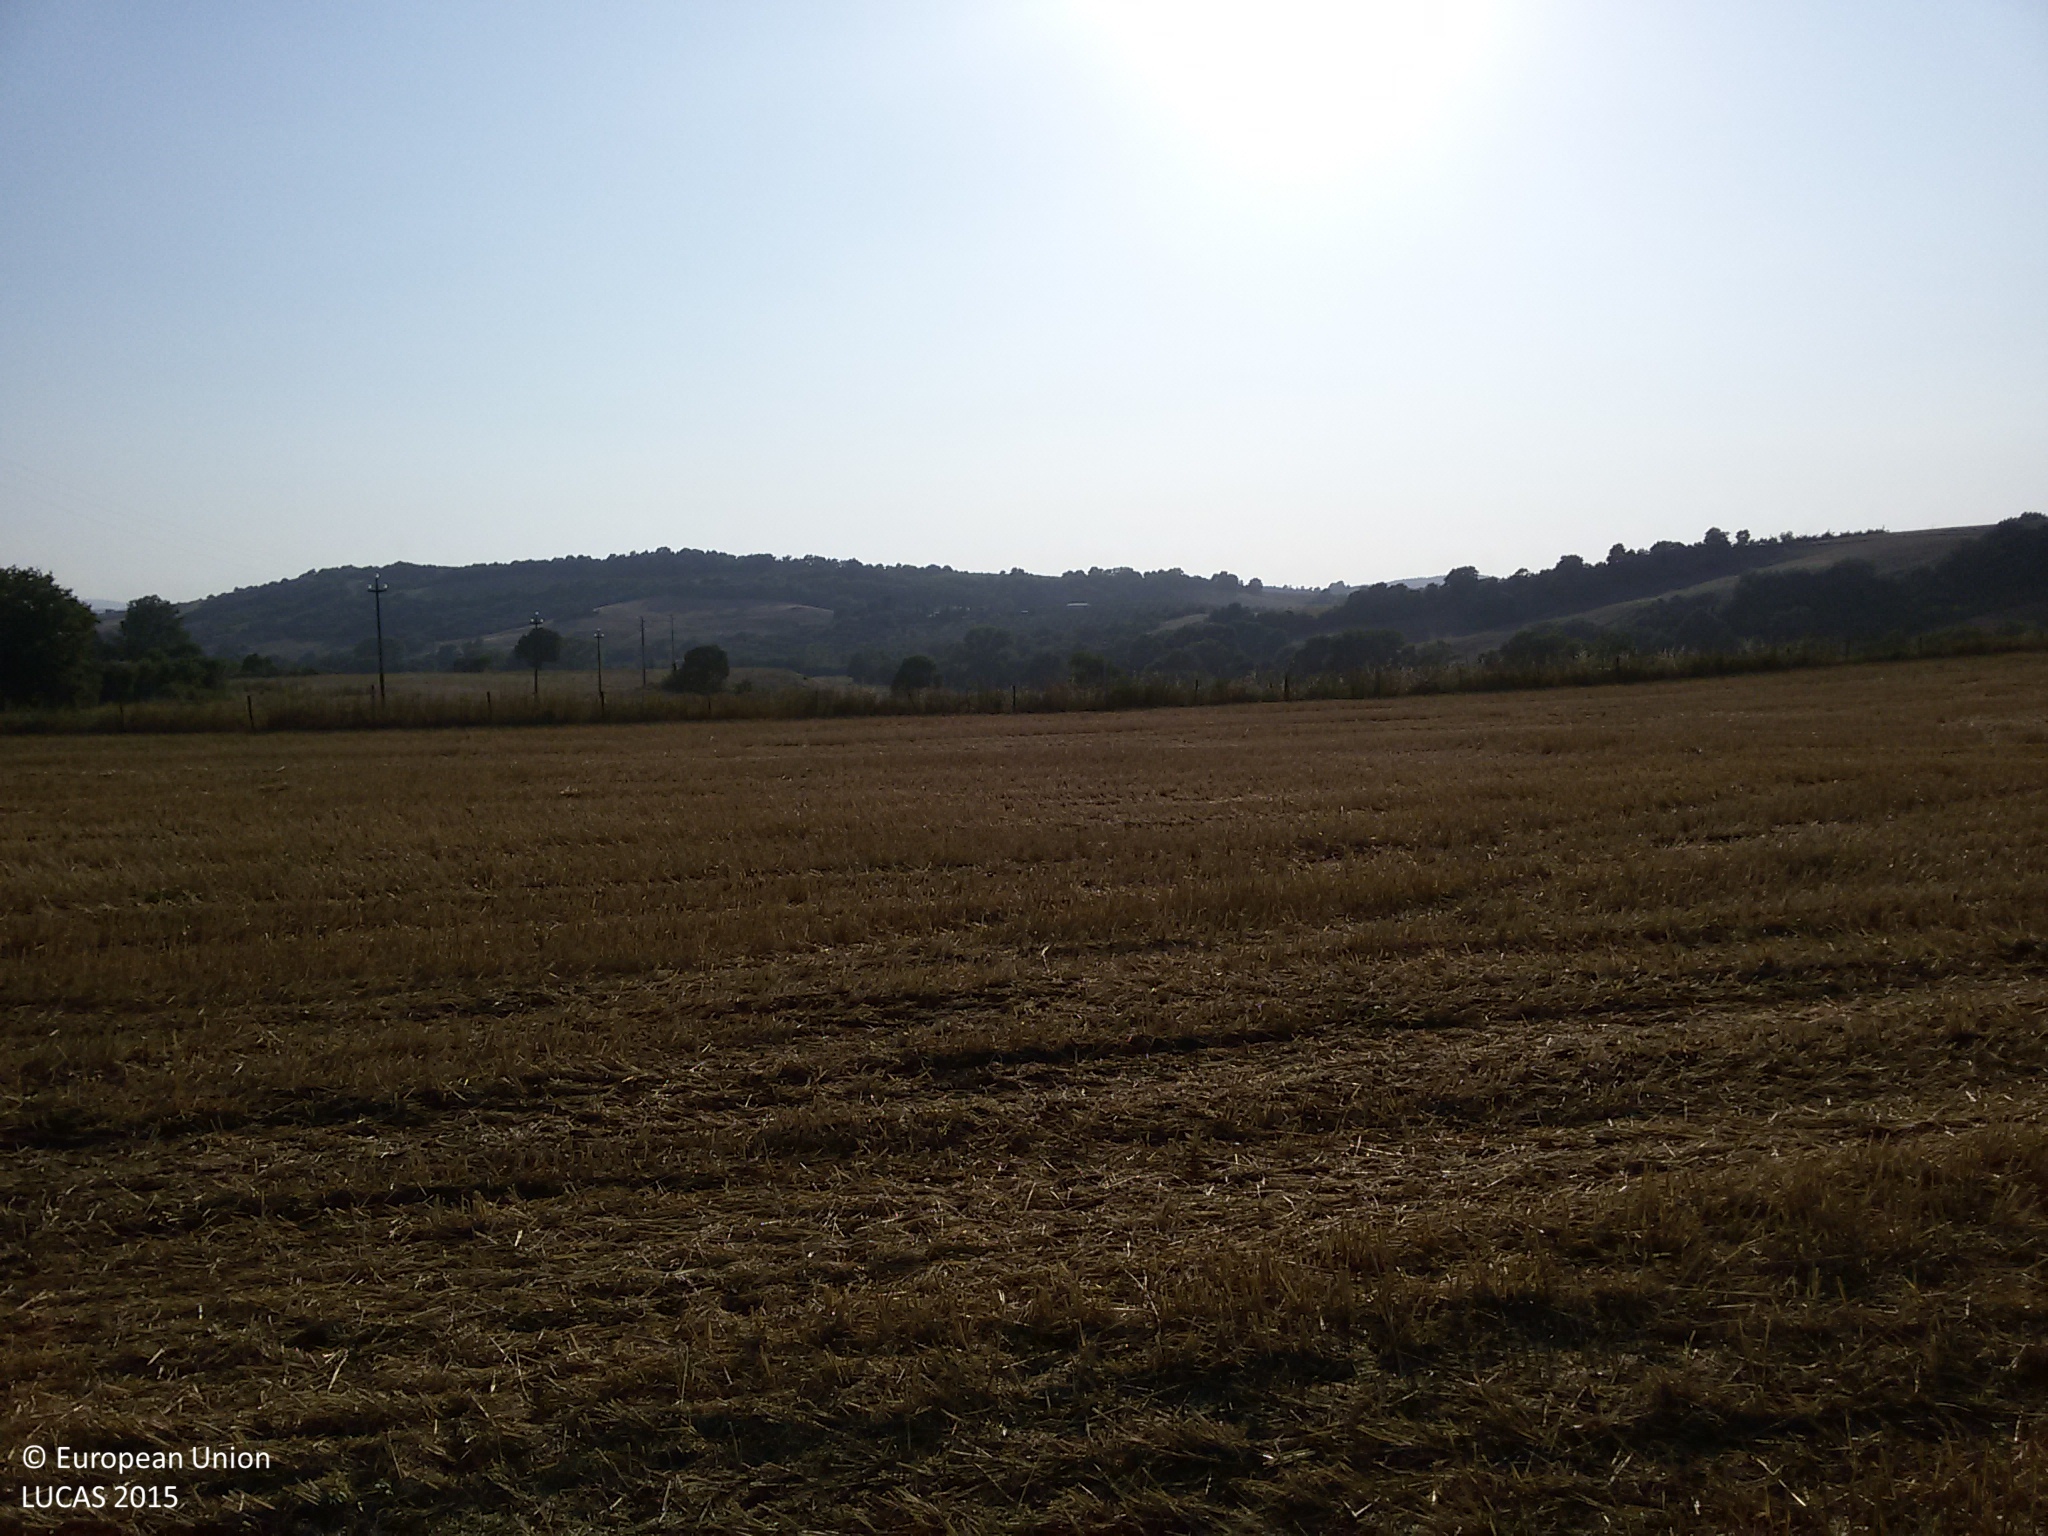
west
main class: Cropland
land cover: Durum wheat
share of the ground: > 75 %
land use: Agriculture (excluding fallow land and kitchen gardens)
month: July
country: IT
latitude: 42.5531
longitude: 11.4687
